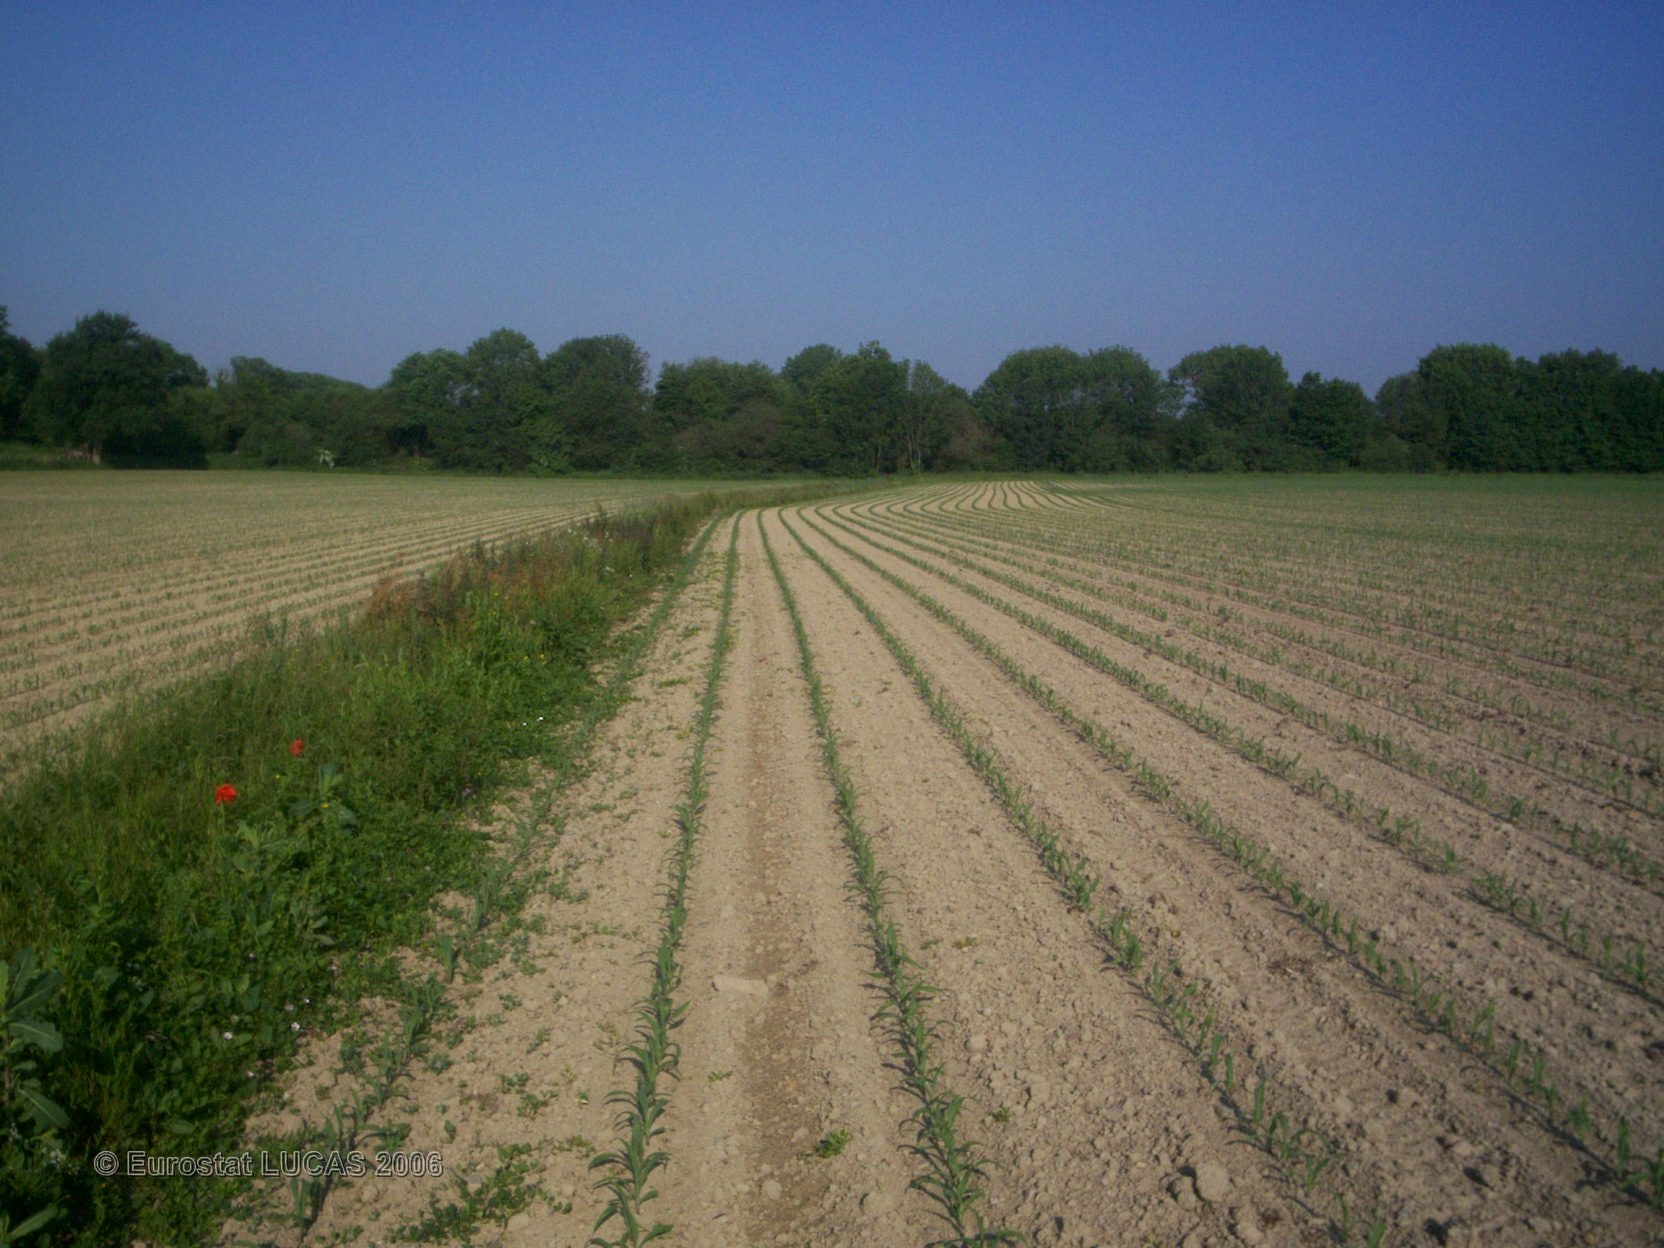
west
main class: Cropland
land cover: Maize
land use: Agriculture (excluding fallow land and kitchen gardens)
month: June
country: FR
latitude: 48.0277
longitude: -1.5923
